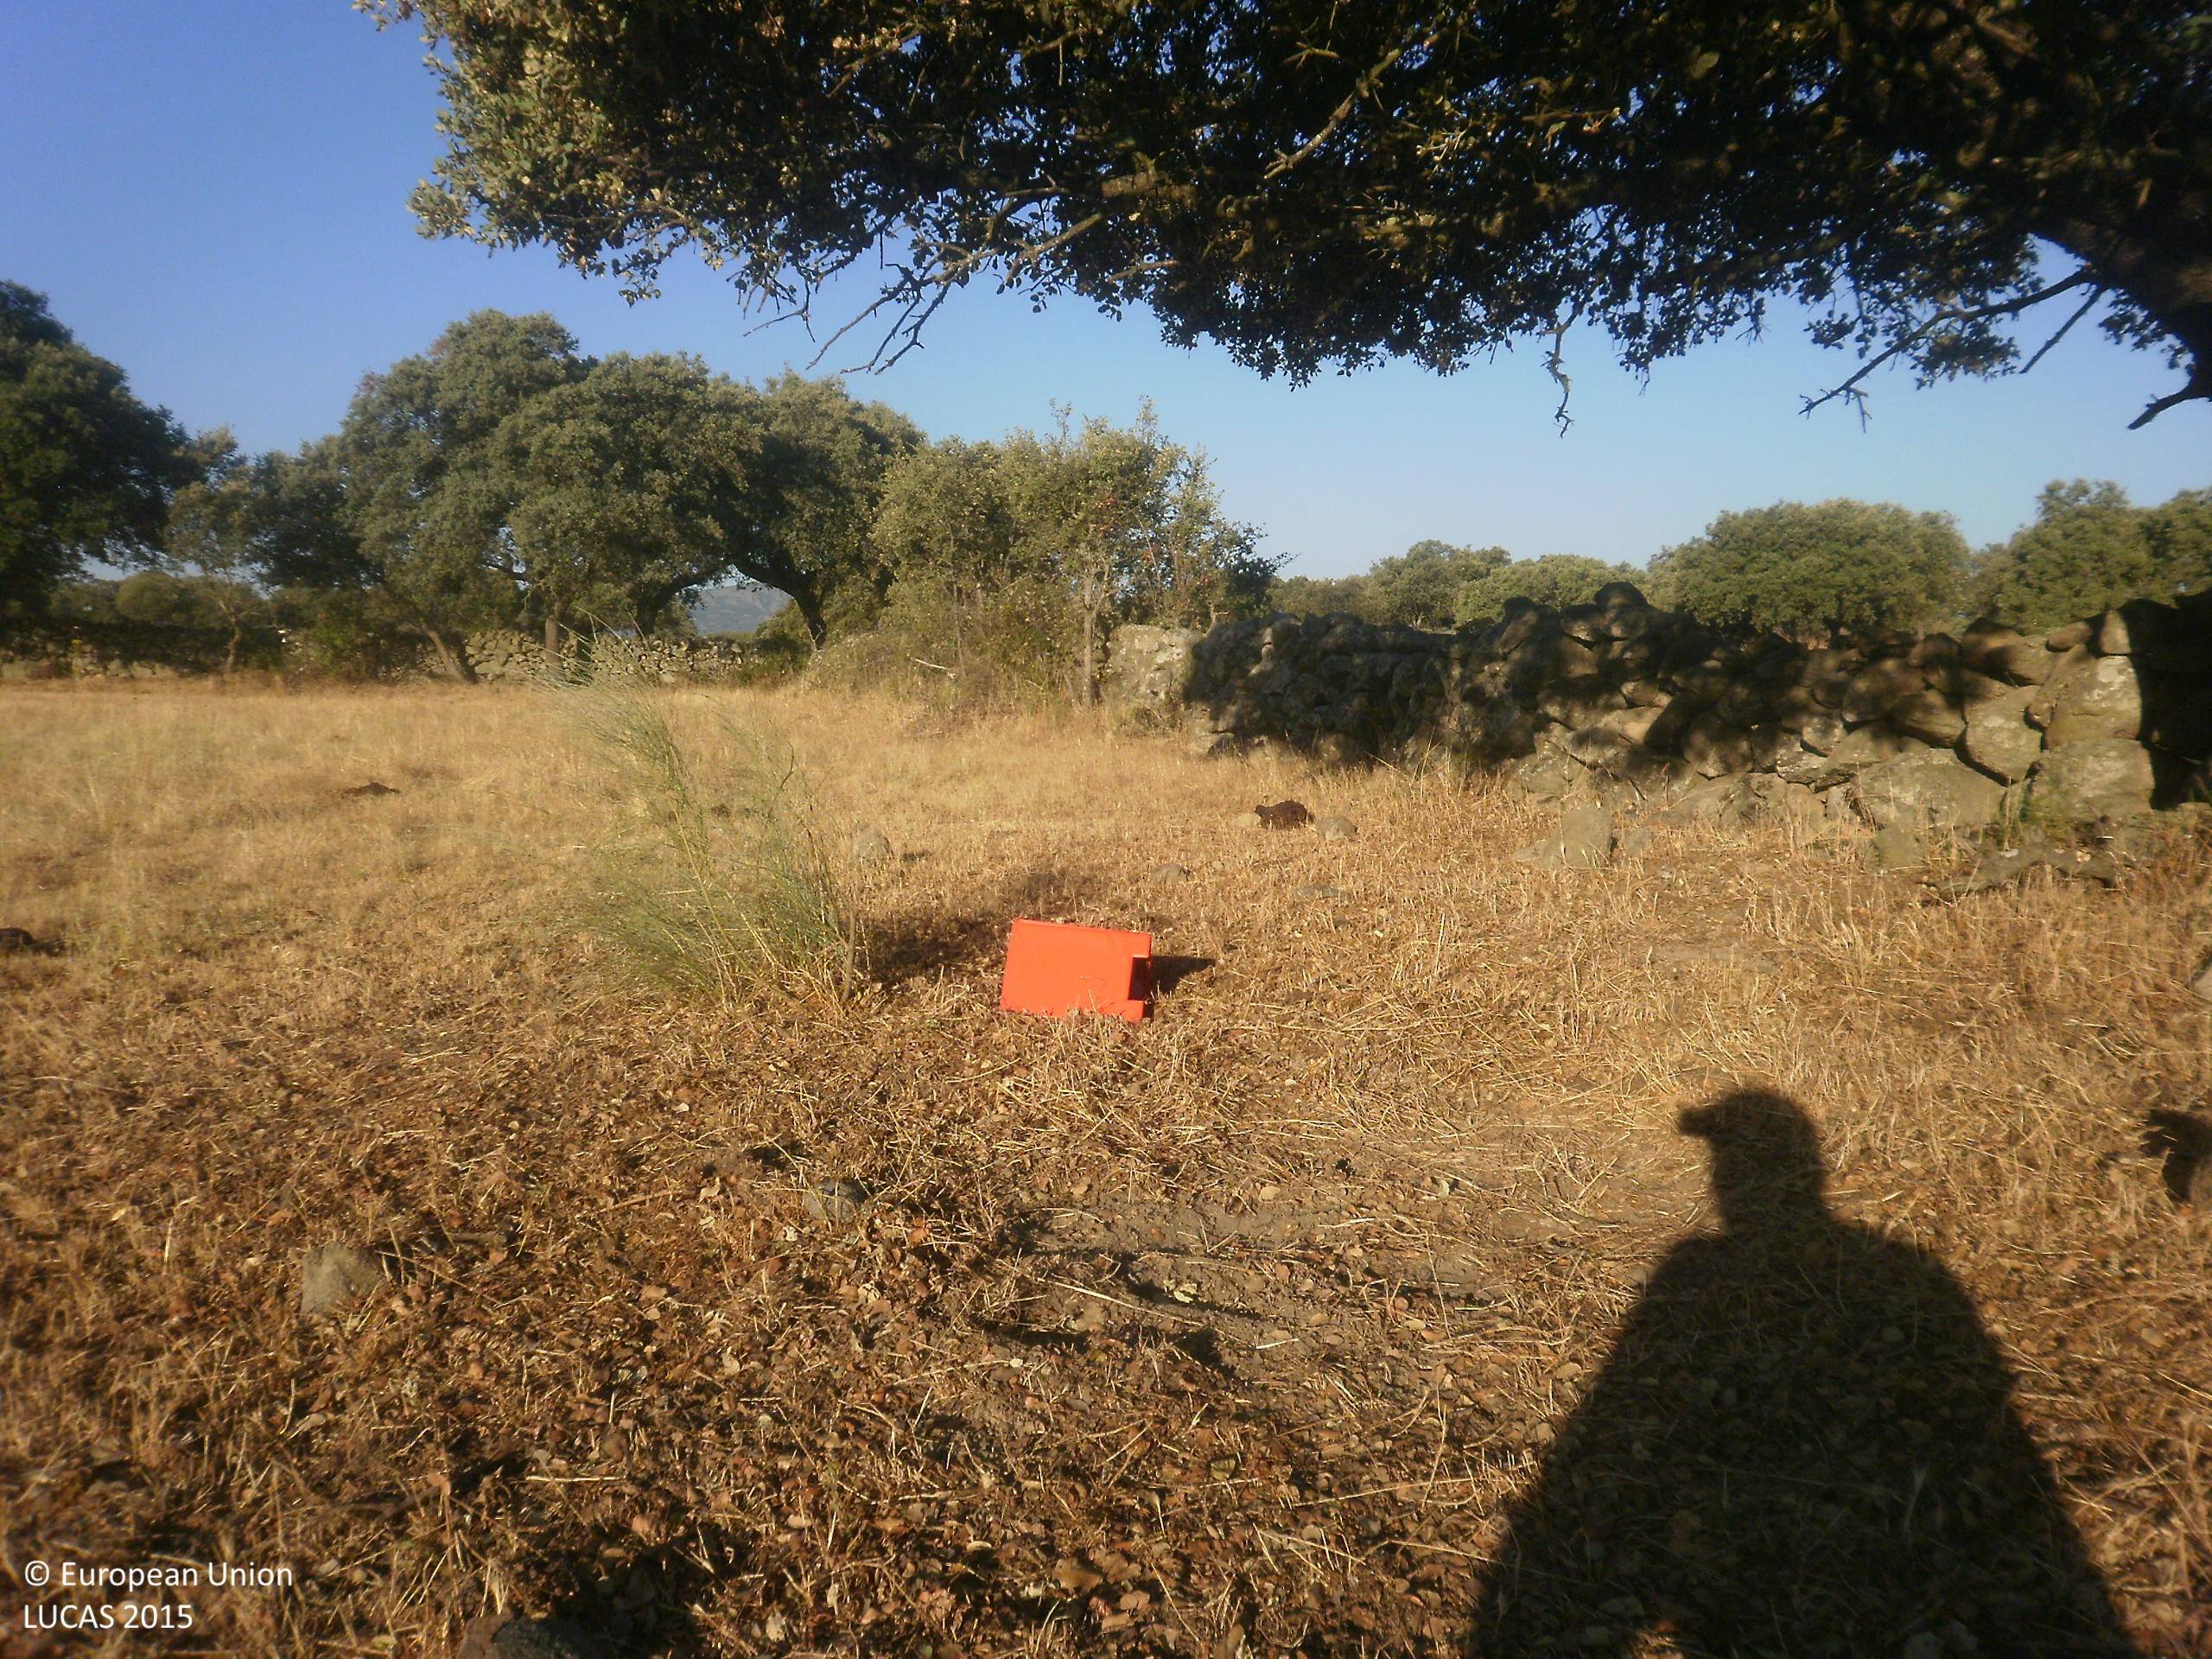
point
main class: Woodland
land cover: Broadleaved woodland
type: broadleaved evergreen forest
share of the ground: 10 - 25 %
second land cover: Grassland without tree/shrub cover
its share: 50 - 75 %
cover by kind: herbaceous plants 90 %, broadleaved forest trees 10 %
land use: Forestry
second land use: Agriculture (excluding fallow land and kitchen gardens)
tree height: > 5 m
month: June
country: ES
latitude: 39.2867
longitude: -6.0459
